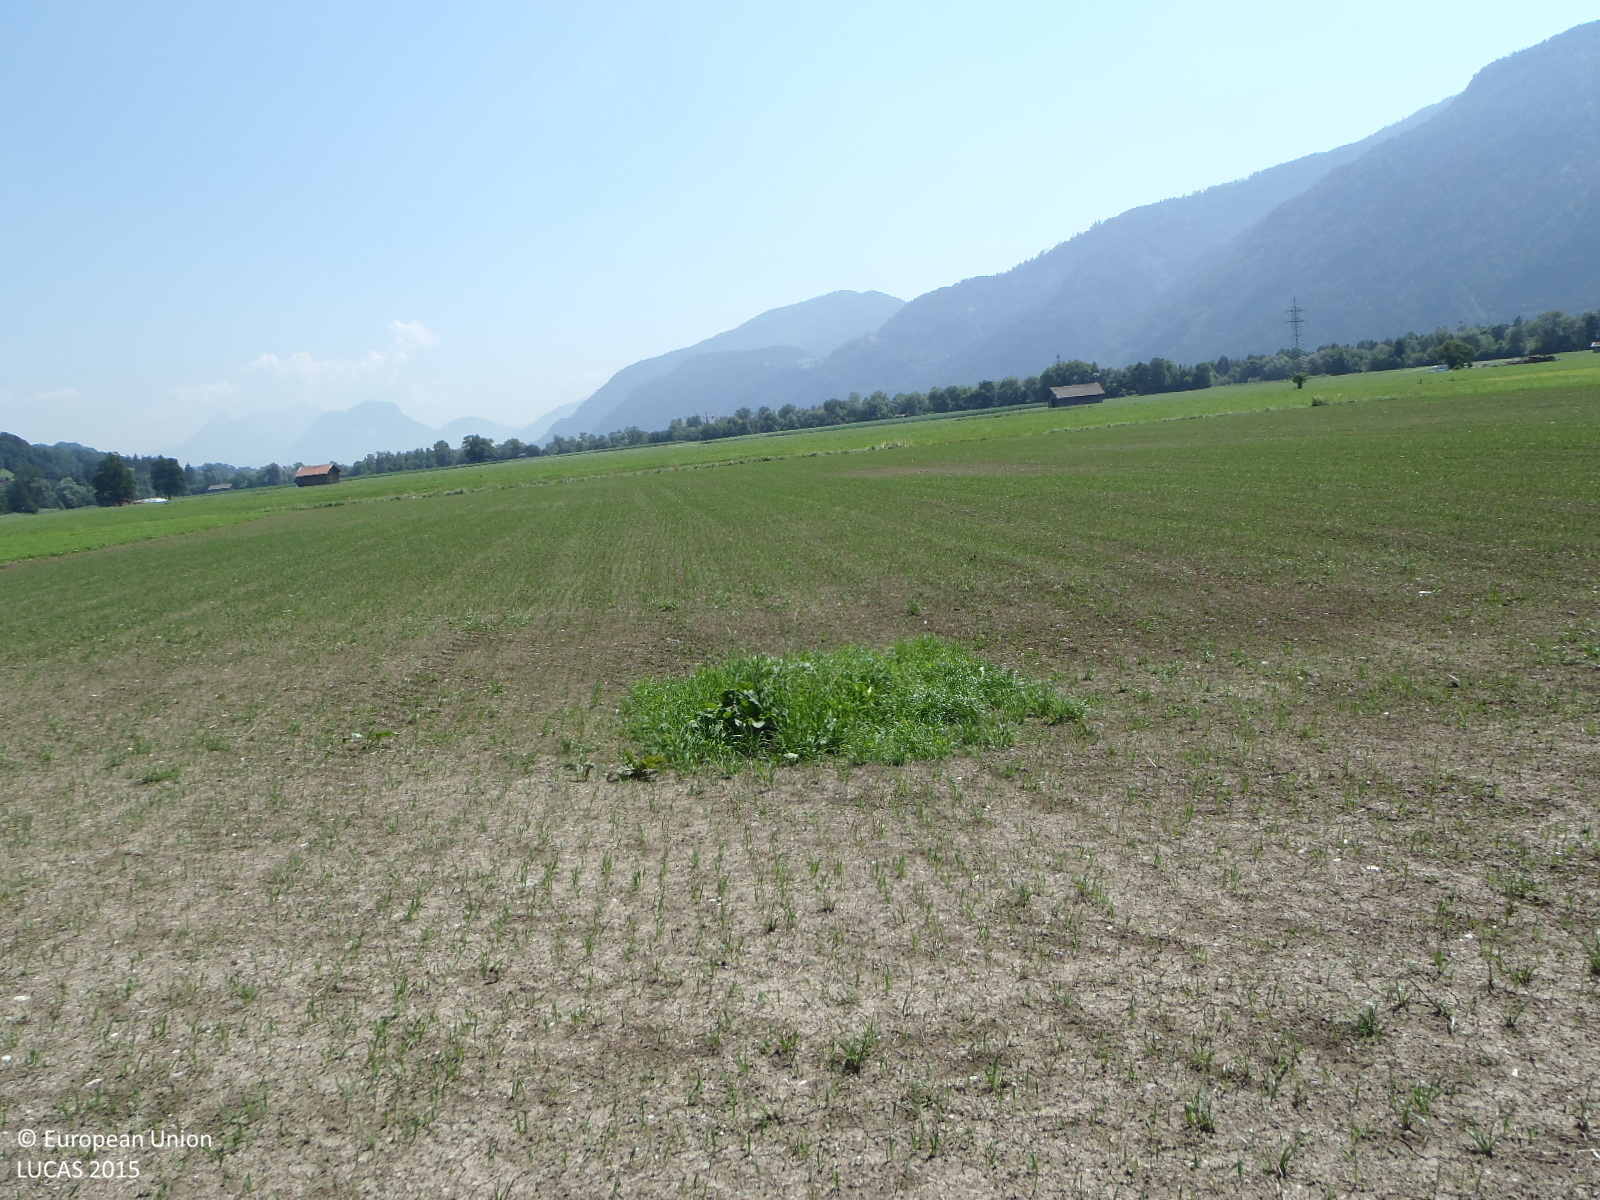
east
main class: Cropland
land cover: Oats
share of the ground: 10 - 25 %
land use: Agriculture (excluding fallow land and kitchen gardens)
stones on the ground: < 10 %
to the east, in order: Oats; Ditches and canals; Grassland without tree/shrub cover
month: July
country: AT
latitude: 47.4511
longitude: 11.8951
